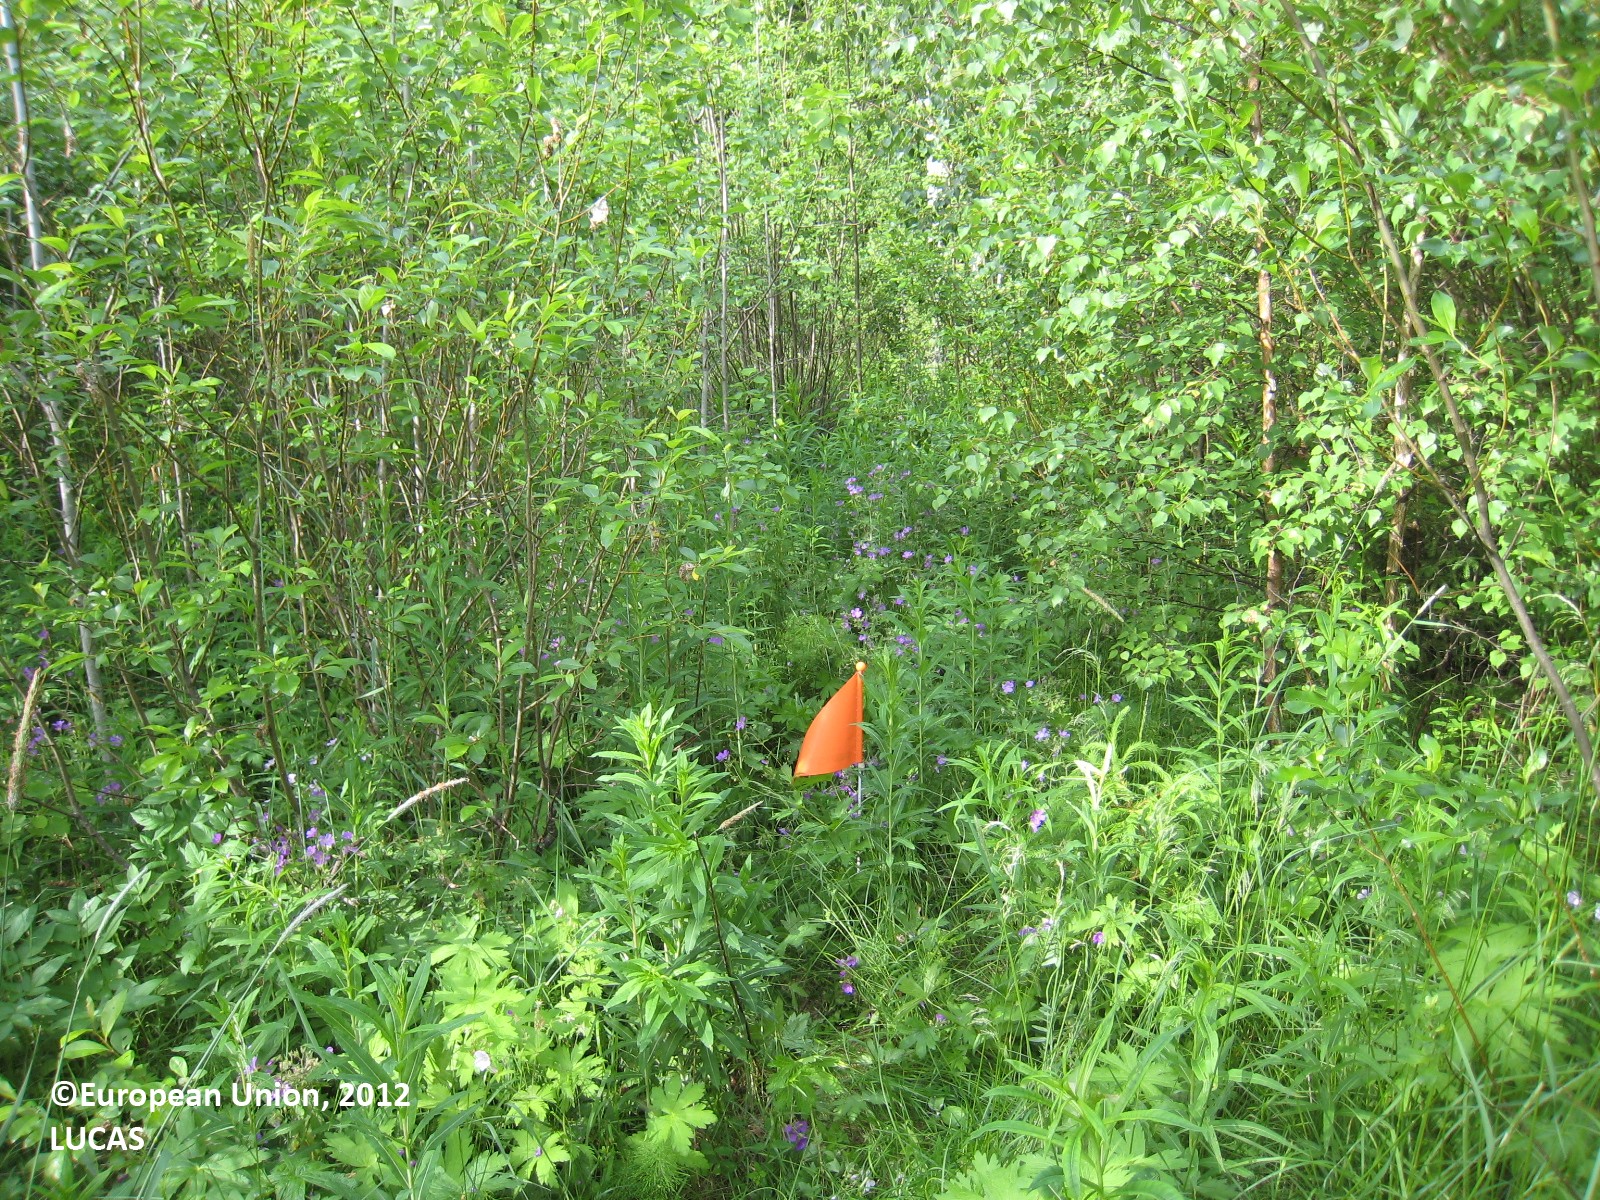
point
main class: Woodland
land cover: Broadleaved woodland
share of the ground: > 75 %
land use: Semi-natural and natural areas not in use
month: June
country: FI
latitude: 62.4545
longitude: 25.9596
